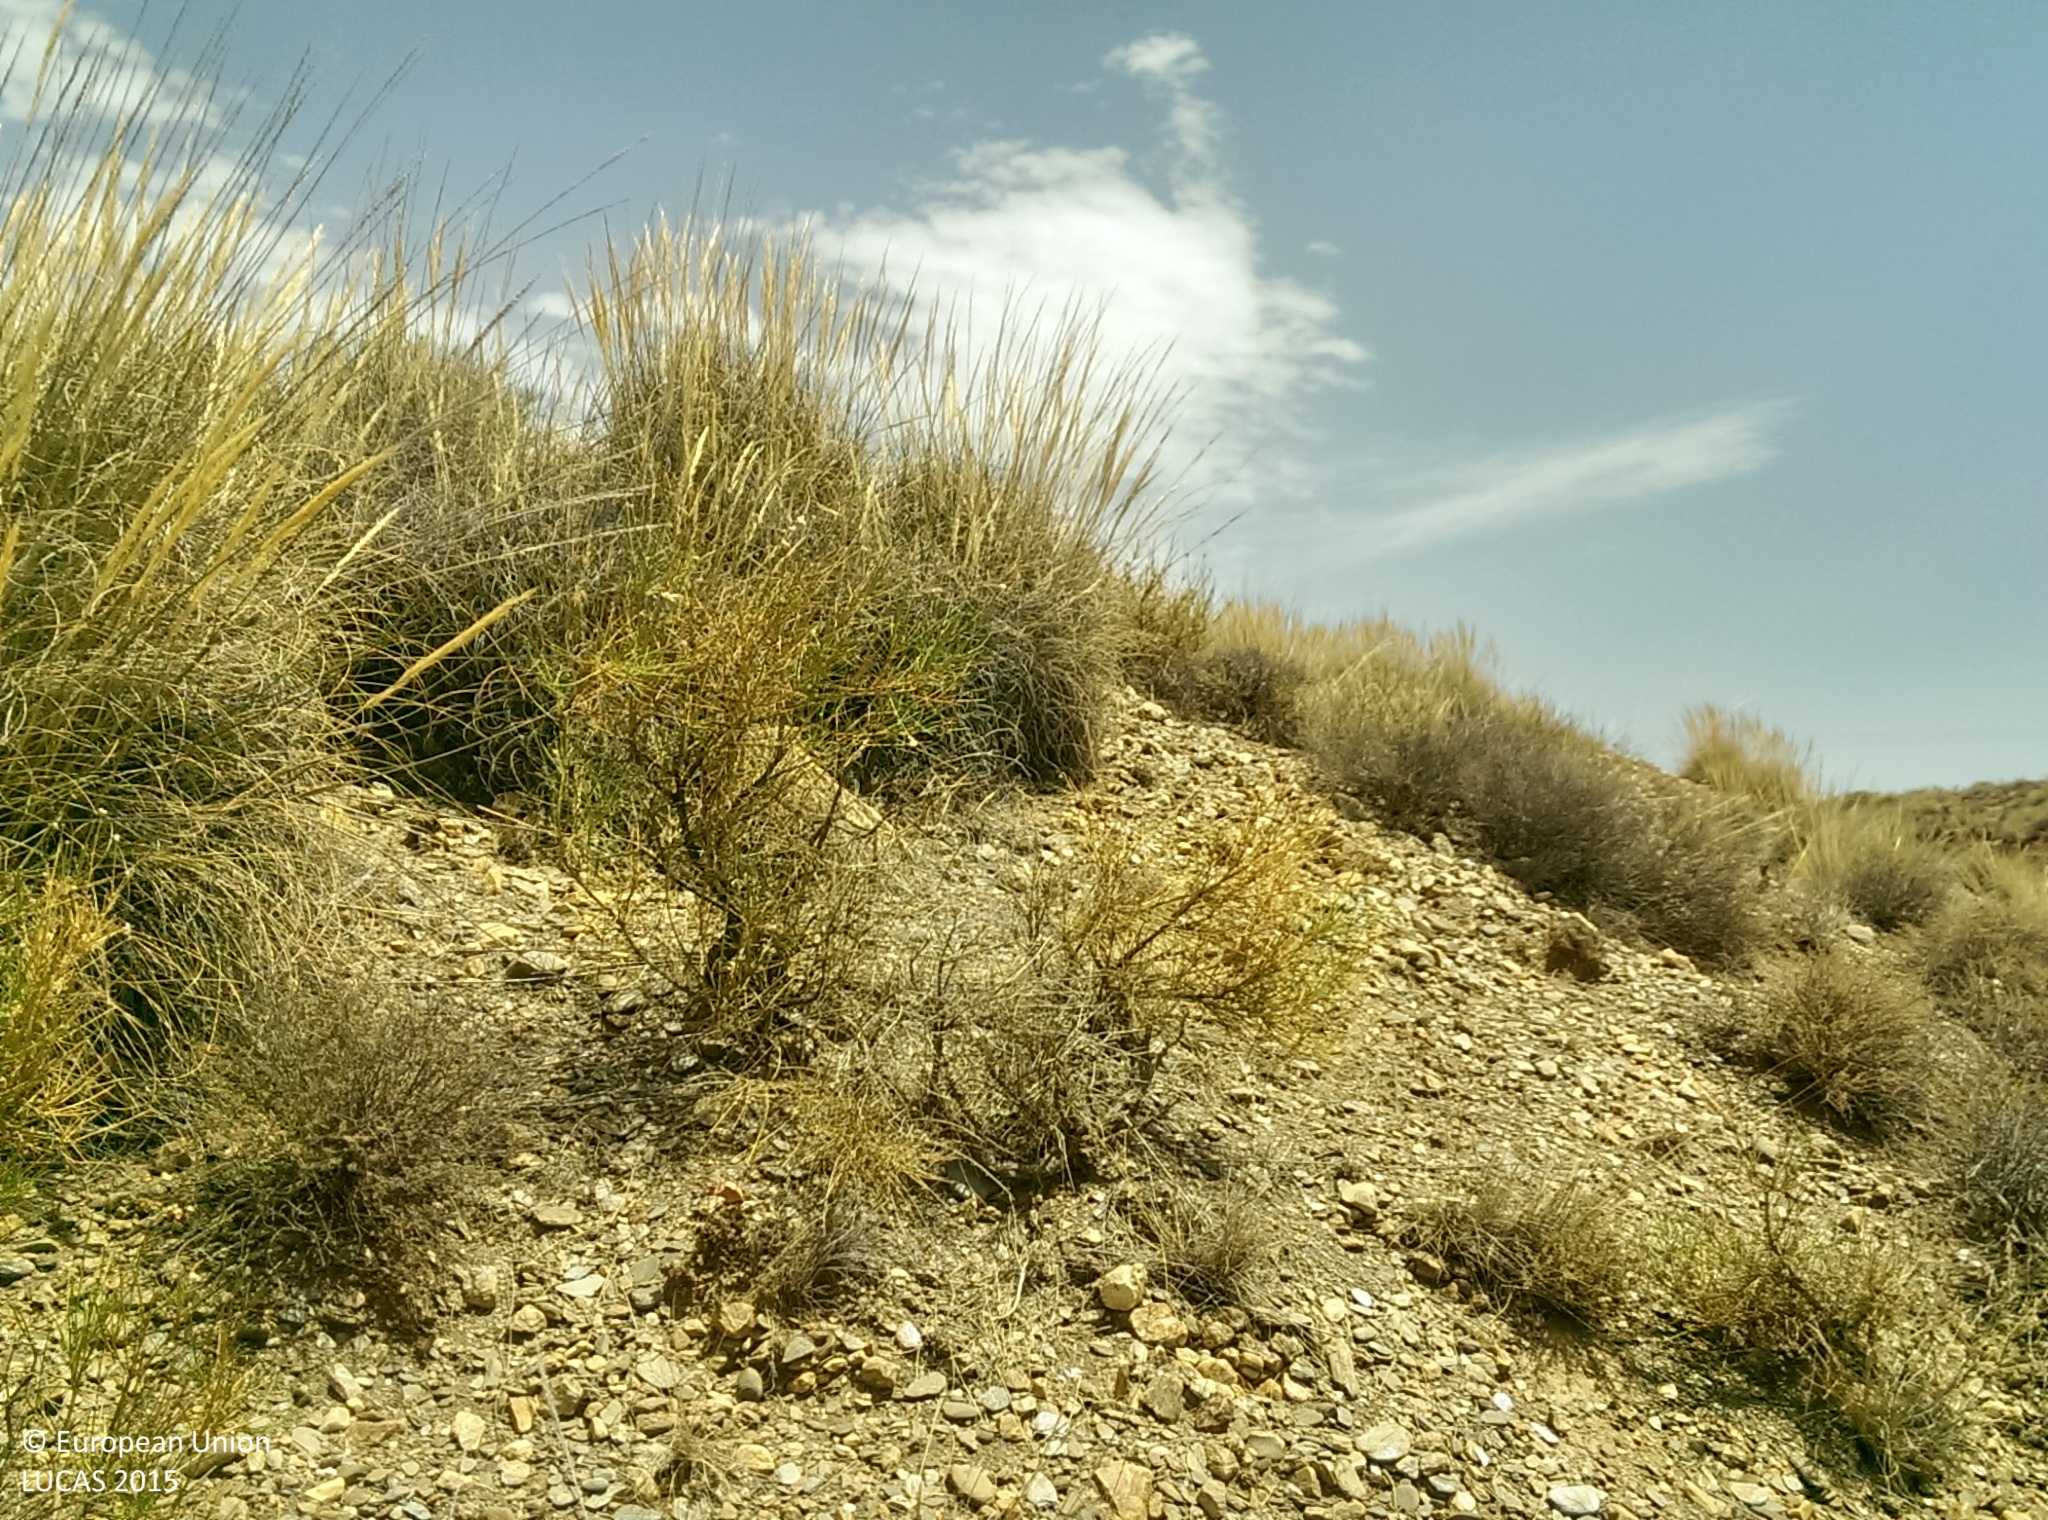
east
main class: Shrubland
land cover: Shrubland without tree cover
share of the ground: 25 - 50 %
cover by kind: shrubs 45 %, unconsolidated bare surface 35 %, herbaceous plants 20 %
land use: Semi-natural and natural areas not in use
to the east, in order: Shrubland without tree cover; Grassland without tree/shrub cover; Barley; Electric lines; Barley
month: July
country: ES
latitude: 37.2234
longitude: -3.0926
